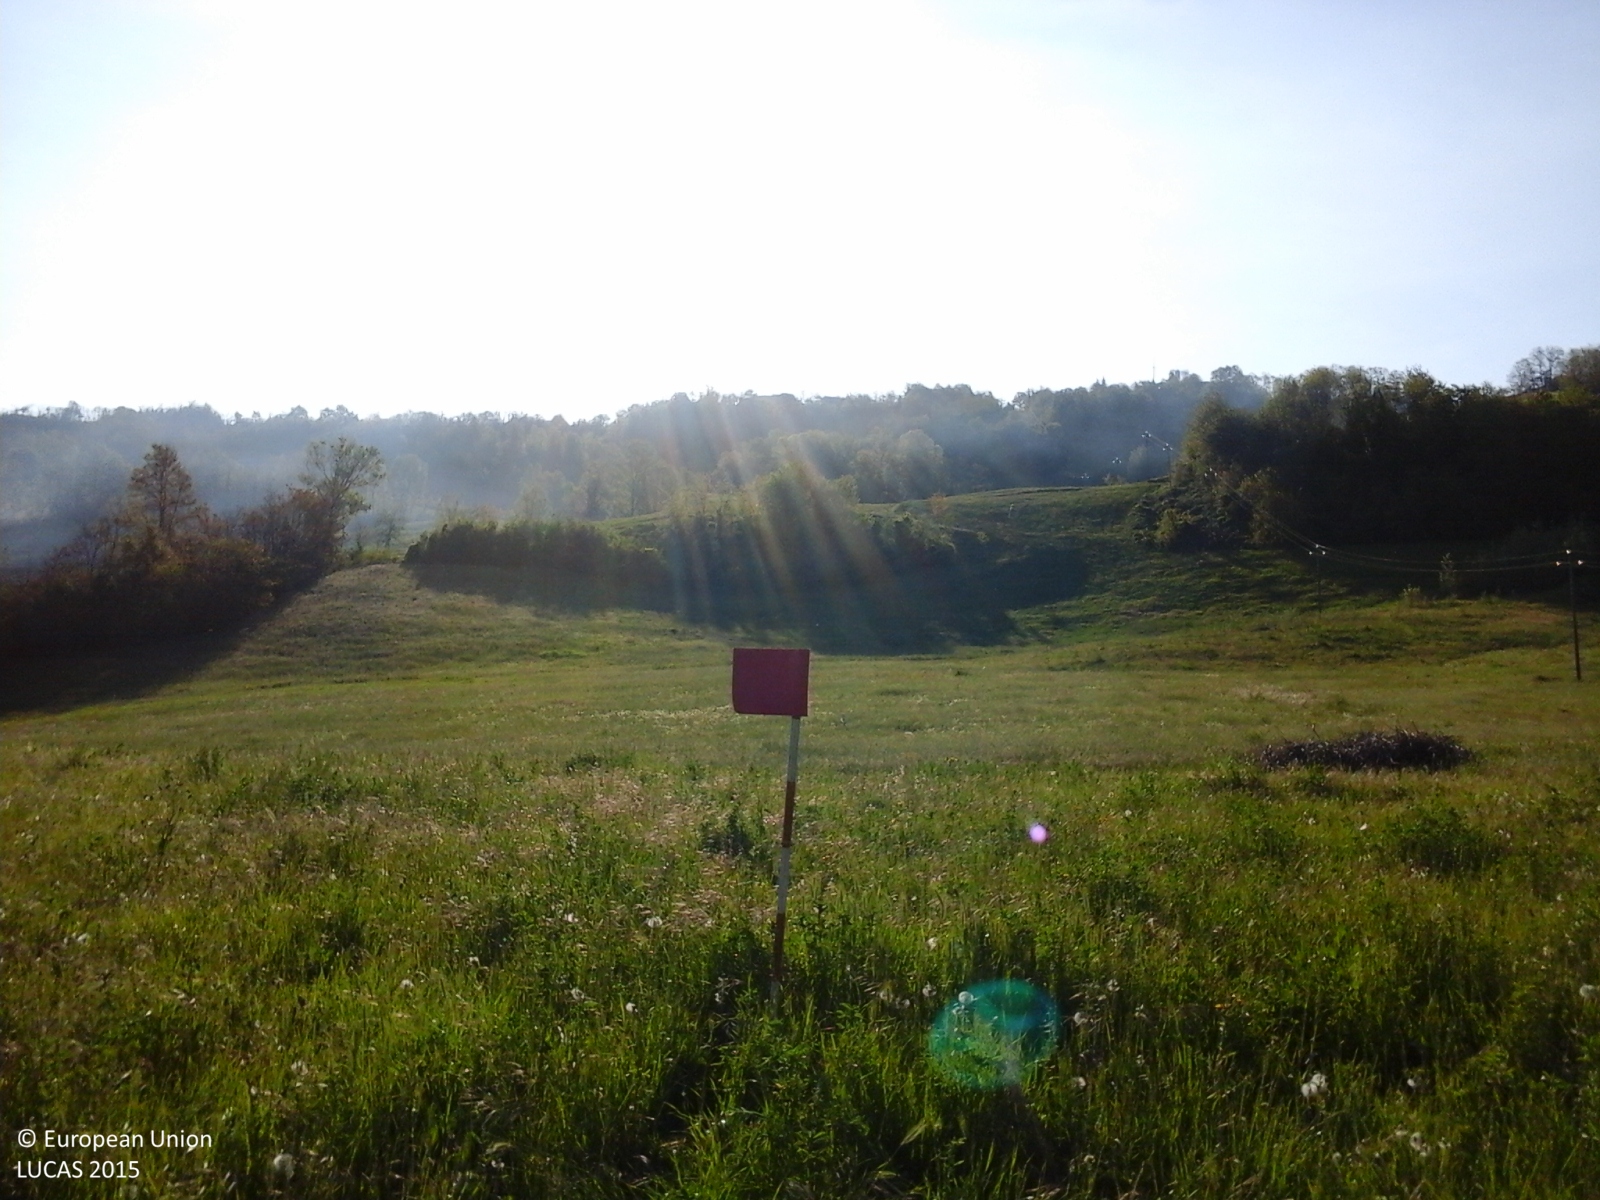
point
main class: Grassland
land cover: Grassland without tree/shrub cover
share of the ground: > 75 %
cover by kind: herbaceous plants 100 %
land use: Agriculture (excluding fallow land and kitchen gardens)
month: April
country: IT
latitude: 44.9258
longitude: 9.3804
